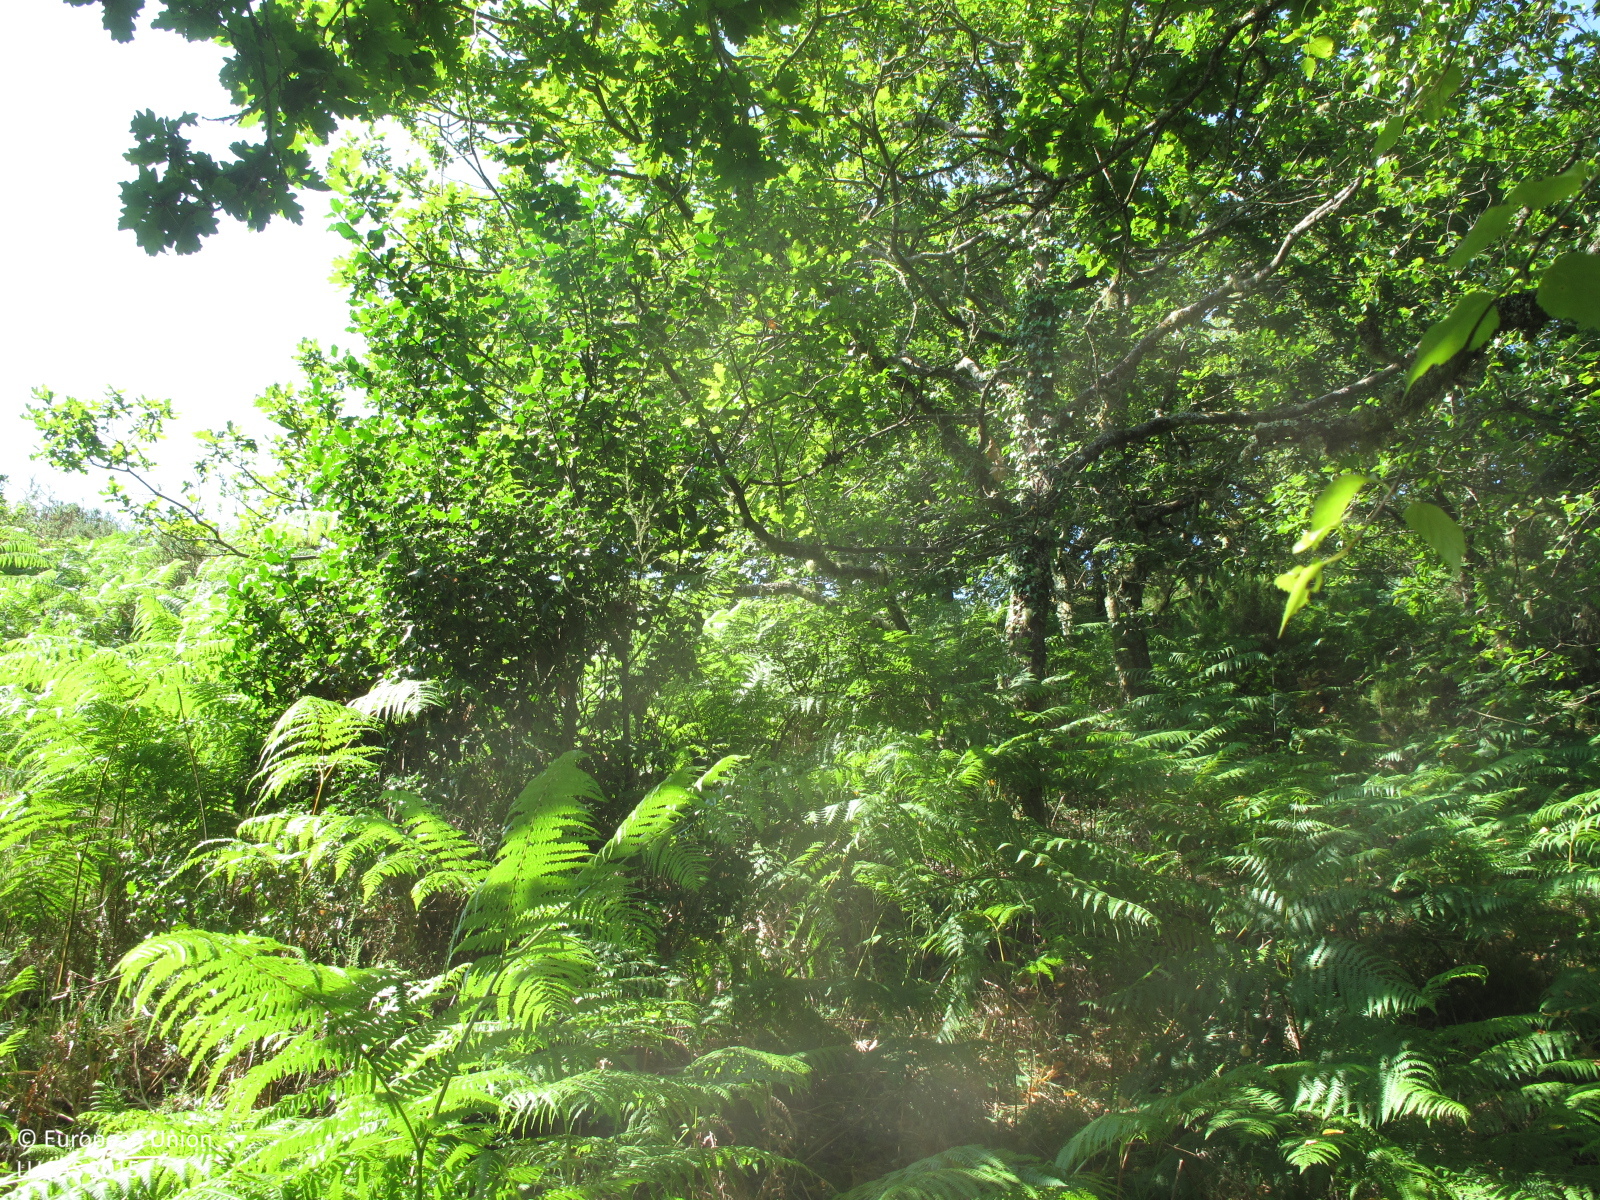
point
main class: Woodland
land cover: Broadleaved woodland
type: acidophilous oak and oak-birch forest
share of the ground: 50 - 75 %
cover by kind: broadleaved forest trees 60 %, shrubs 30 %, herbaceous plants 10 %
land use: Semi-natural and natural areas not in use
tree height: > 5 m
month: July
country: ES
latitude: 43.3341
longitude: -7.9900
